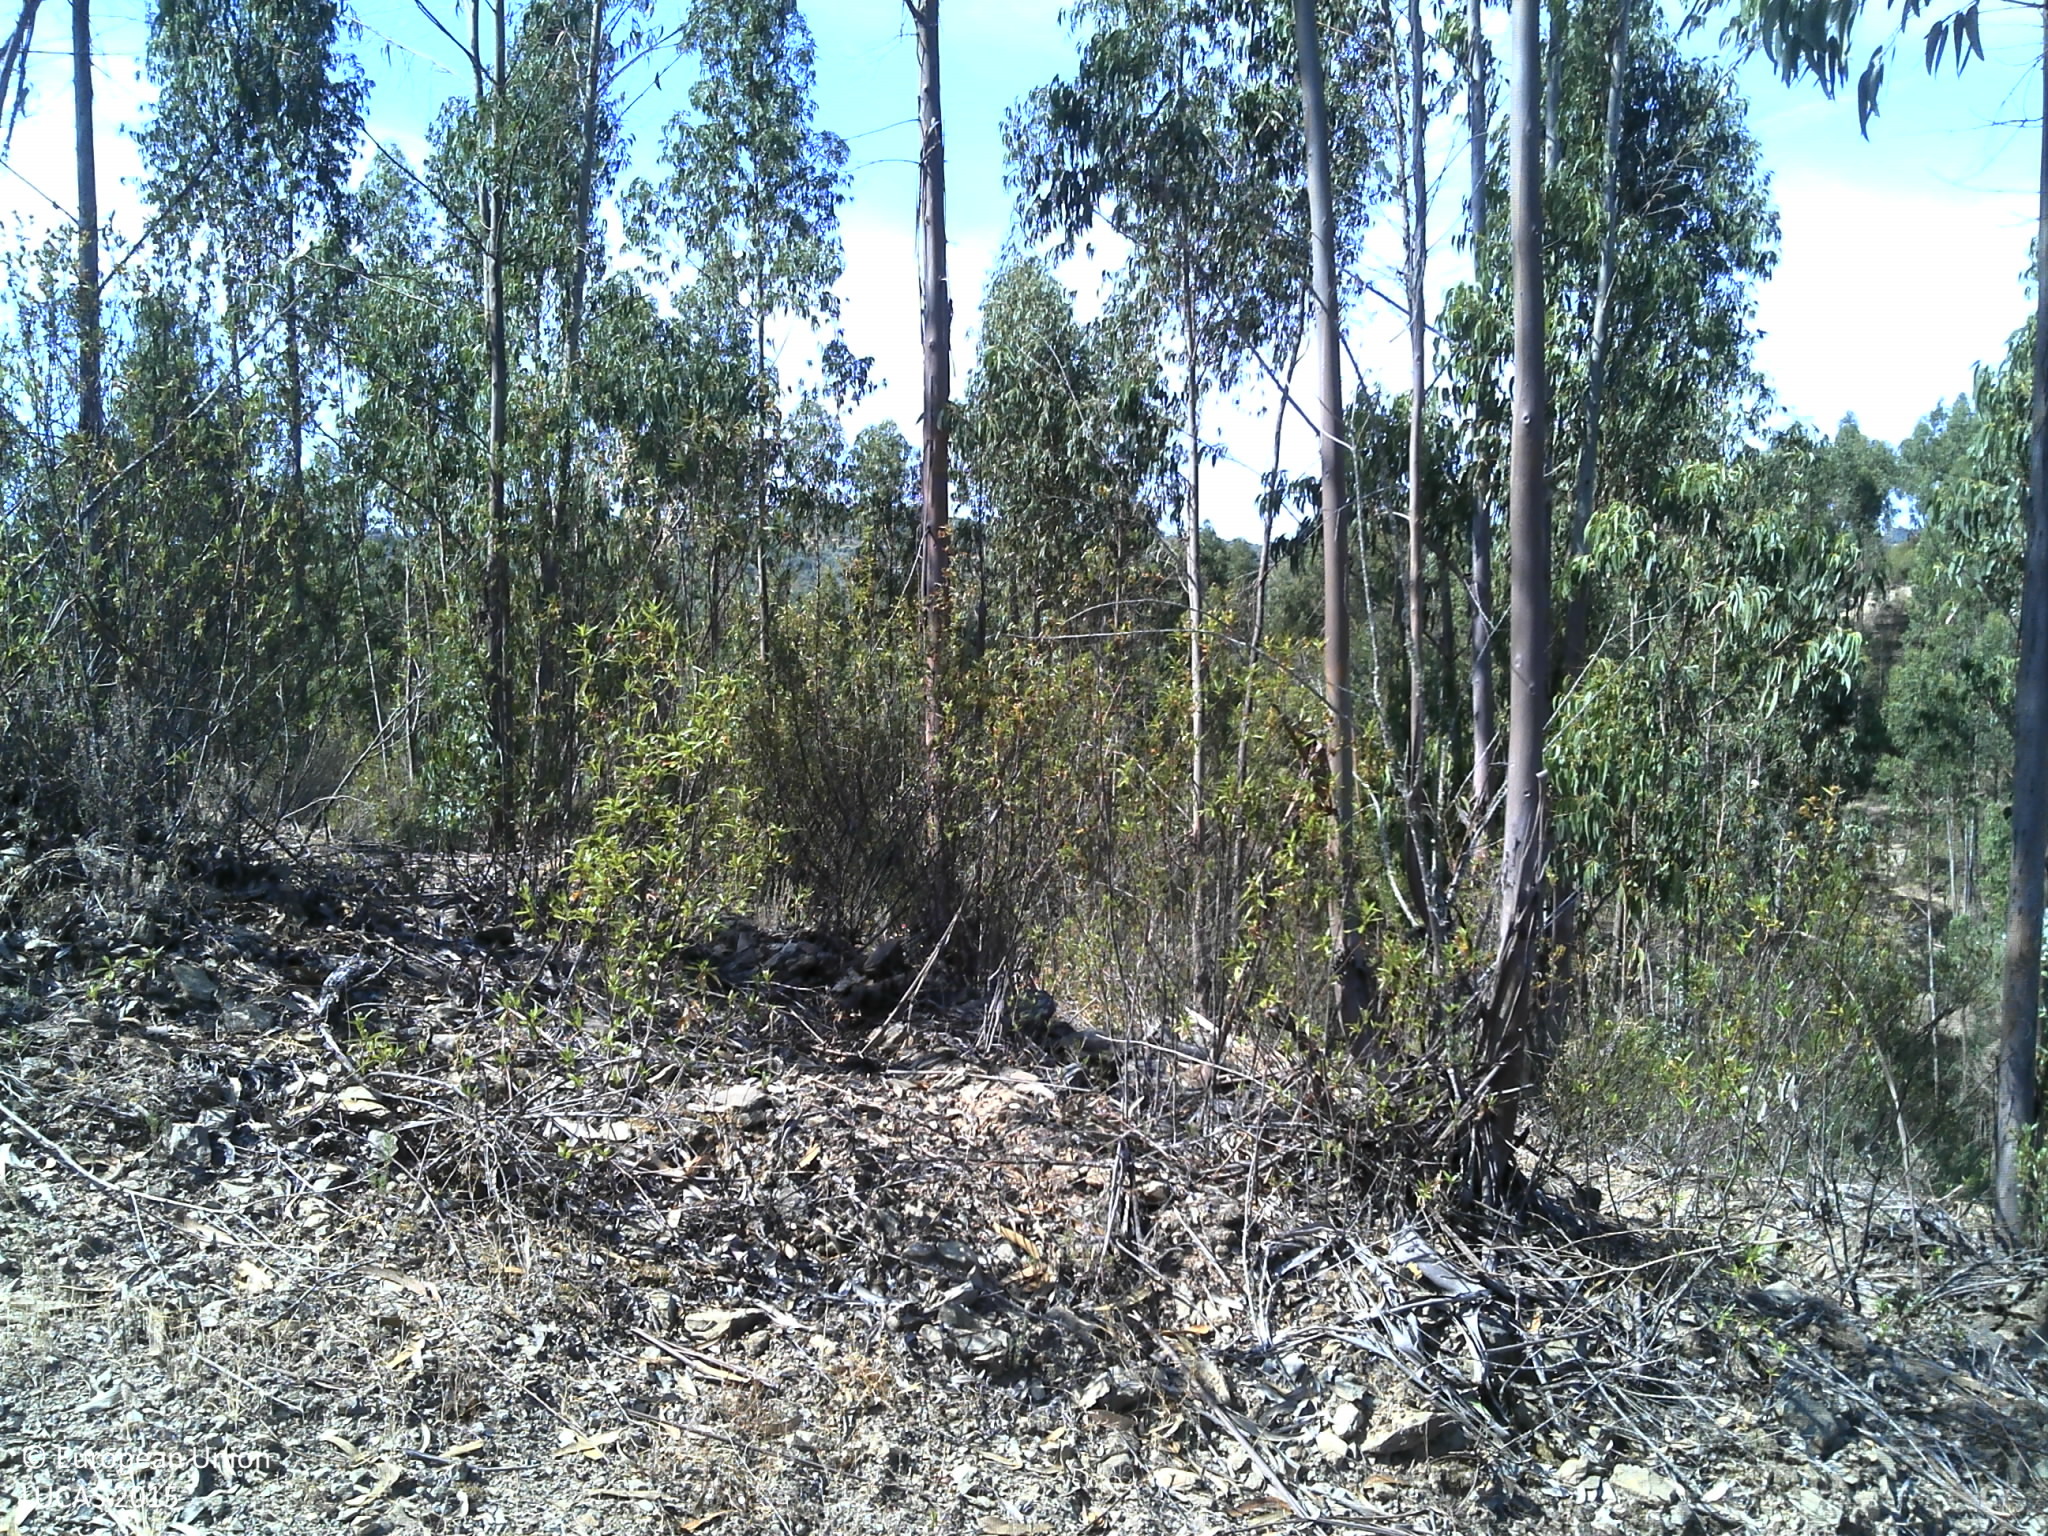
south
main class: Shrubland
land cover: Shrubland without tree cover
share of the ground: 50 - 75 %
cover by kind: shrubs 75 %, unconsolidated bare surface 25 %
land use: Semi-natural and natural areas not in use
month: July
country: PT
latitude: 39.4877
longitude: -7.9277
